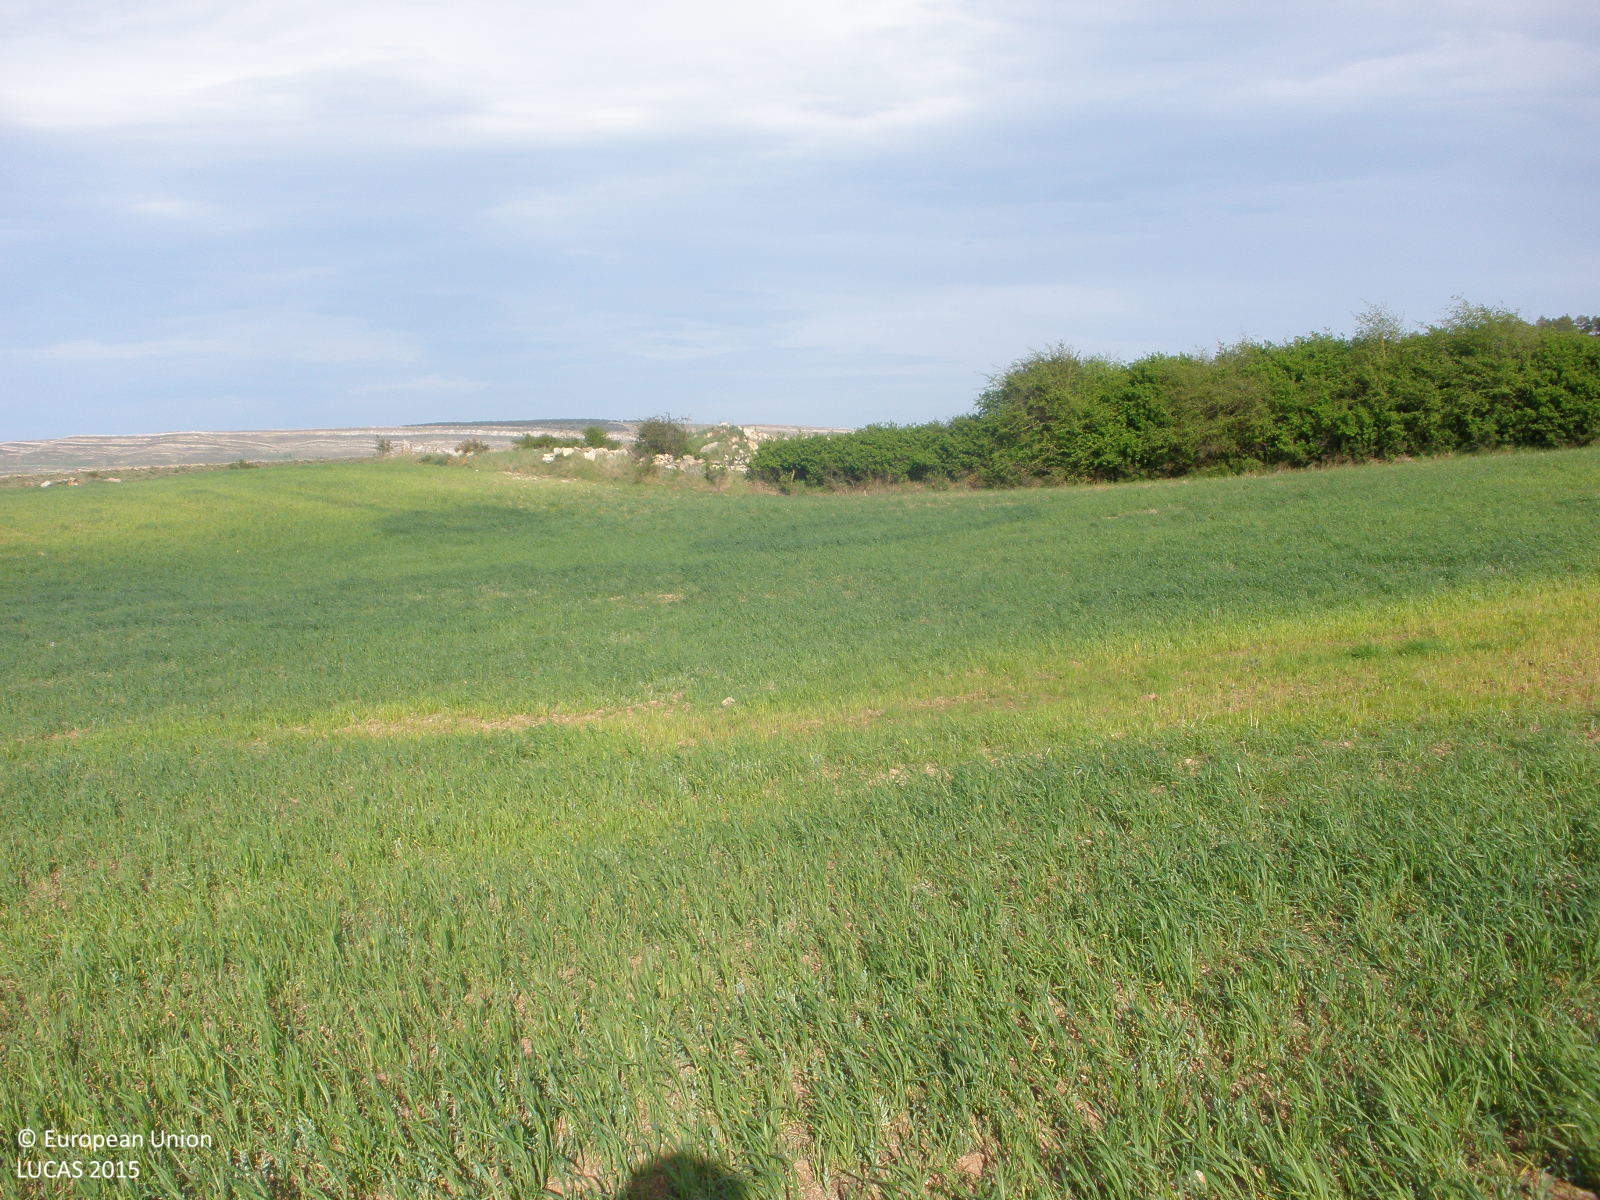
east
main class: Cropland
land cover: Common wheat
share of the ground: > 75 %
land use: Agriculture (excluding fallow land and kitchen gardens)
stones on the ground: 10 - 25 %
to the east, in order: Common wheat; Abandoned hedges; Spontaneously vegetated surfaces; Shrubland without tree cover; Rivers and streams; Grass margins; Spontaneously vegetated surfaces; Rock outcrops; Shrubland without tree cover; Shruby margins; Spontaneously vegetated surfaces
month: May
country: ES
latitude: 40.6172
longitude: -0.8033
